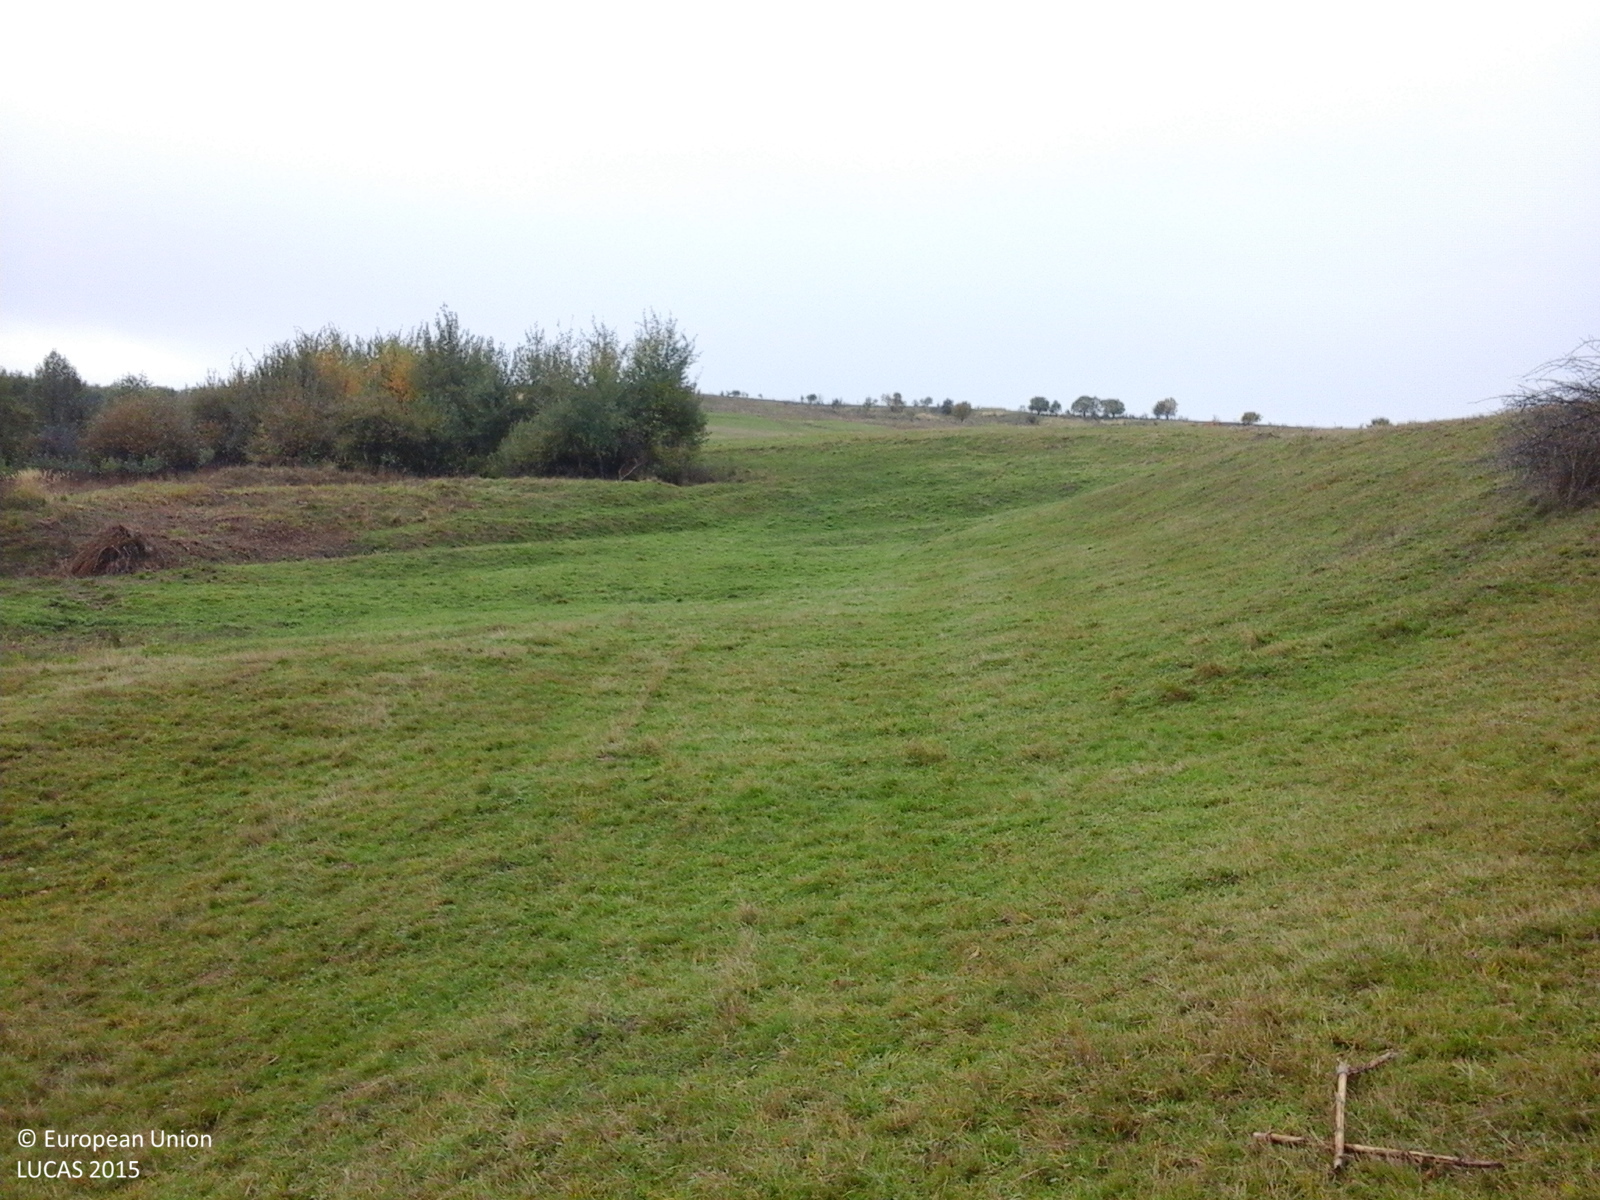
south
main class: Grassland
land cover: Grassland without tree/shrub cover
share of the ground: > 75 %
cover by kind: herbaceous plants 100 %
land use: Agriculture (excluding fallow land and kitchen gardens)
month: October
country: RO
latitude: 46.6508
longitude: 24.9273
